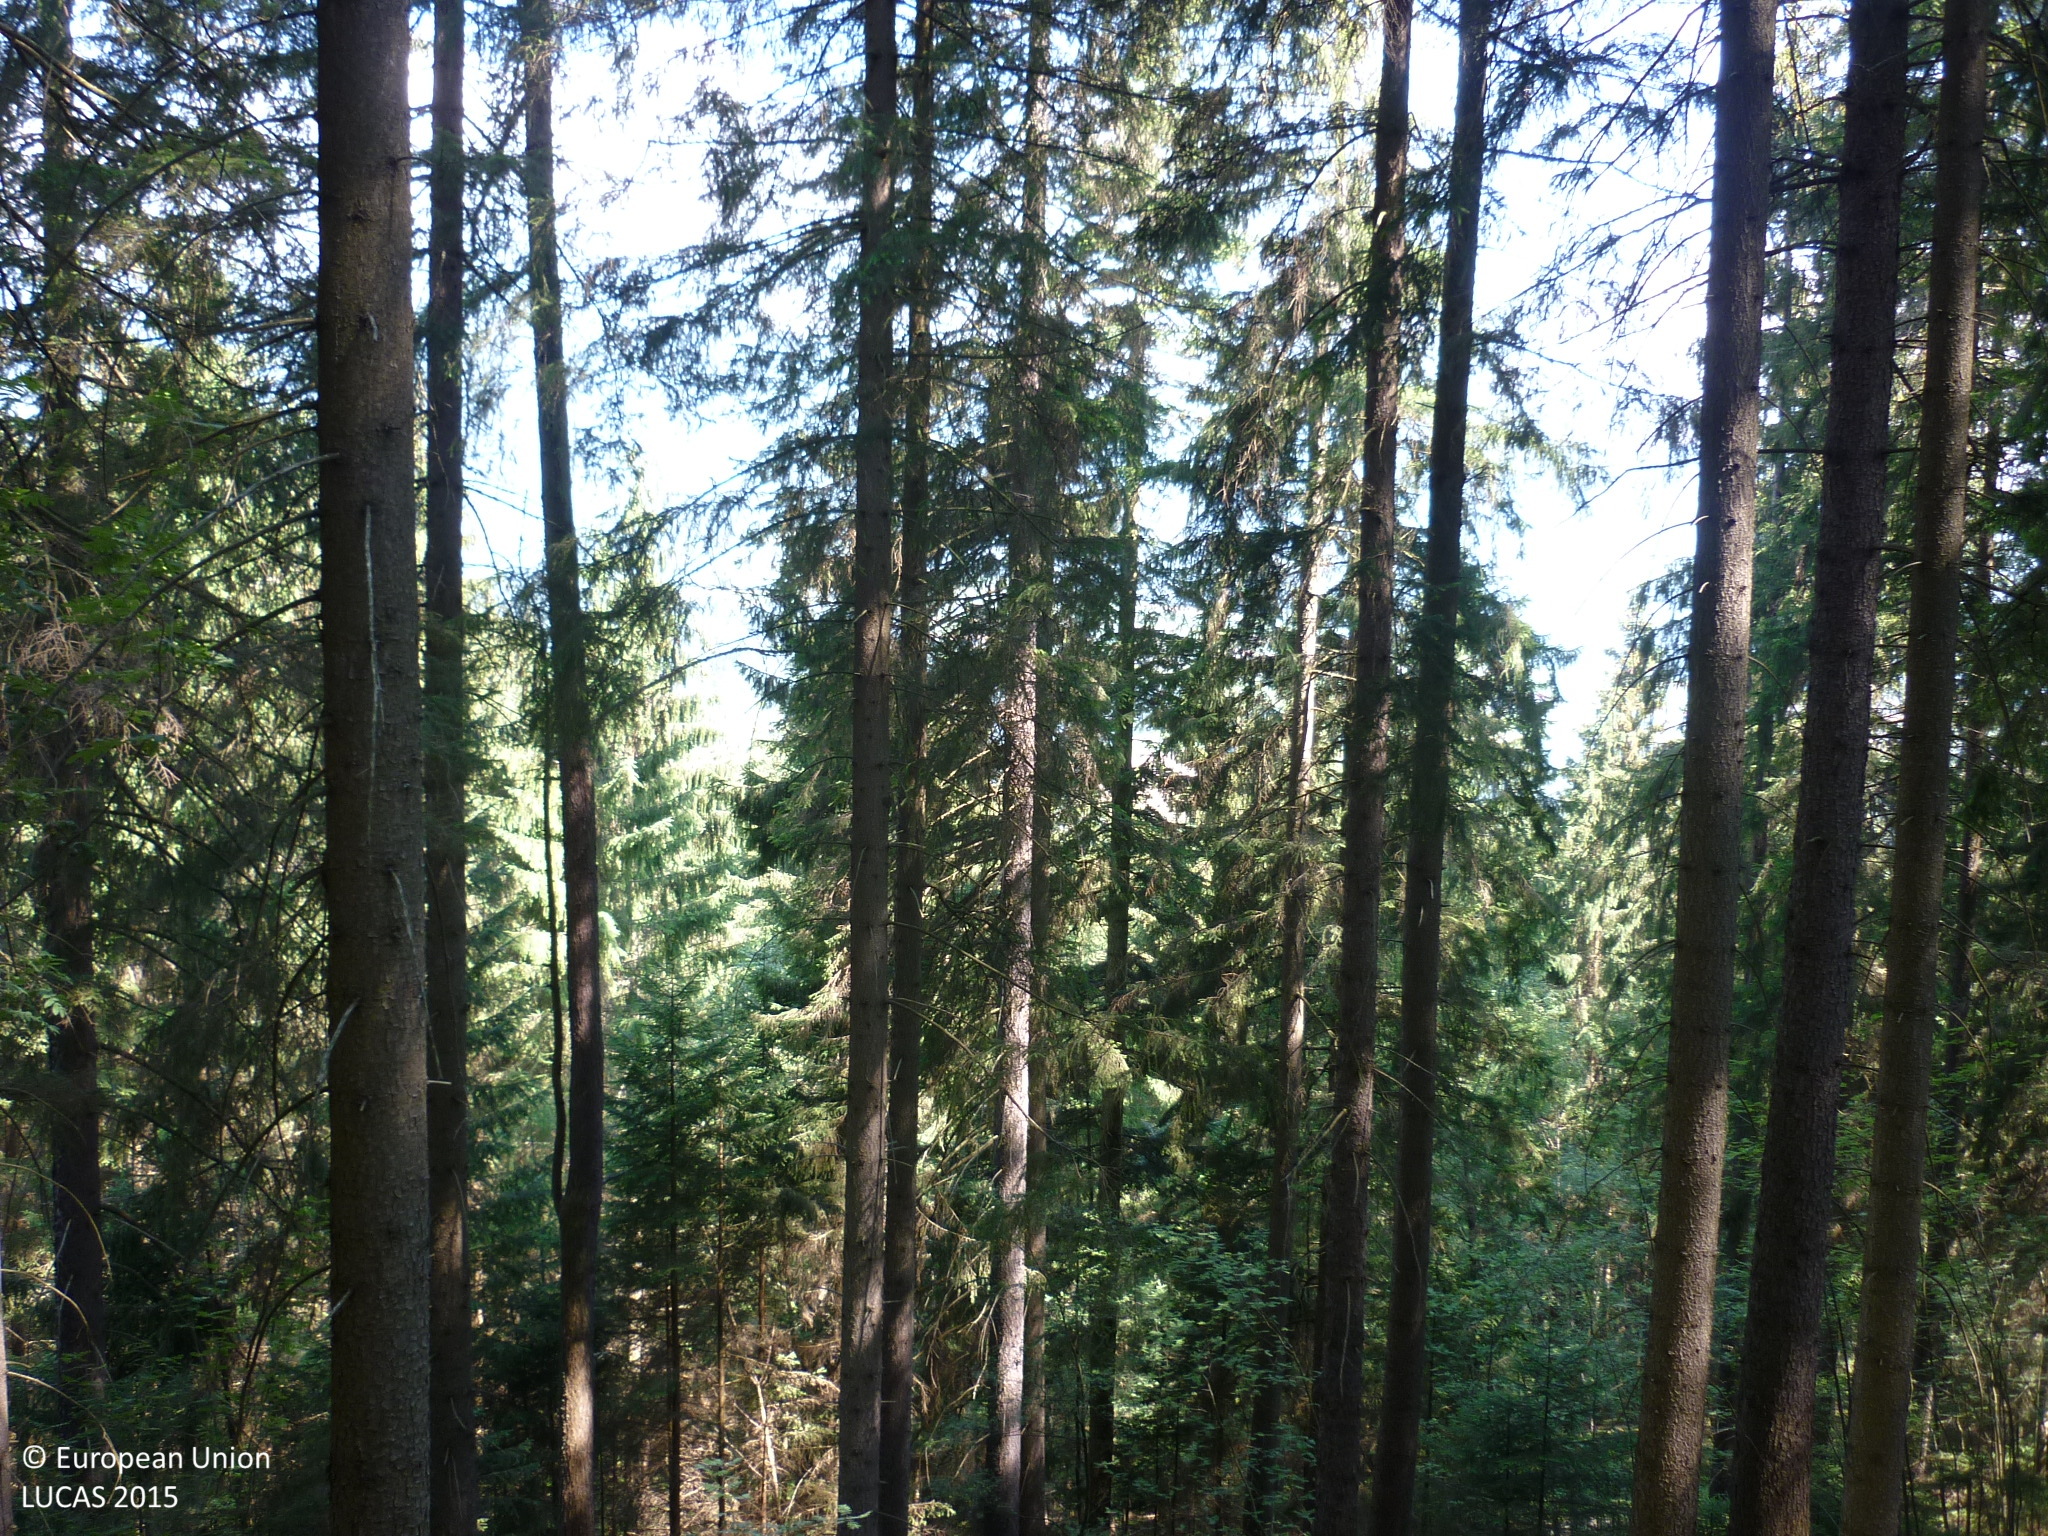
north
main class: Woodland
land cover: Spruce dominated coniferous woodland
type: alpine coniferous forest
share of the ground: > 75 %
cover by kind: coniferous forest trees 90 %, broadleaved forest trees 5 %, herbaceous plants 5 %
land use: Forestry
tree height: > 5 m
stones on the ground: < 10 %
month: July
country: AT
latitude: 47.2526
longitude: 14.8221
